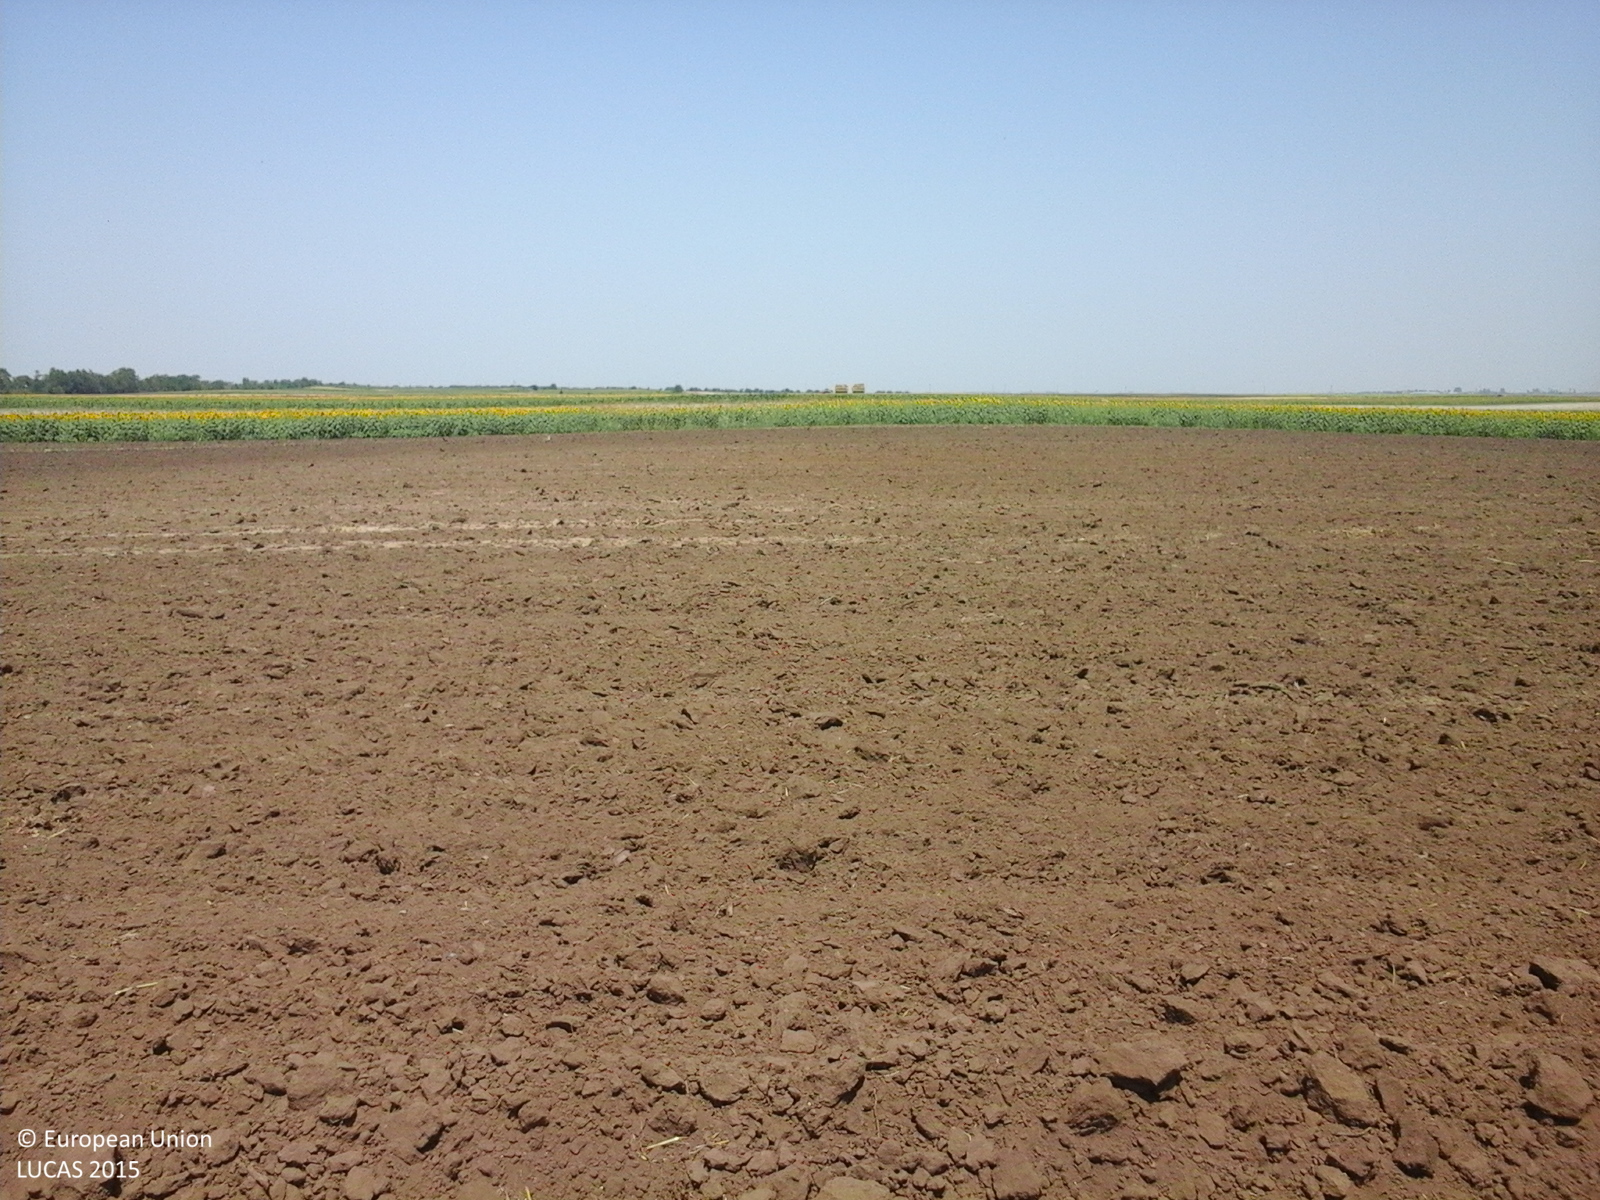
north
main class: Cropland
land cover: Rape and turnip rape
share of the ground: < 10 %
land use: Agriculture (excluding fallow land and kitchen gardens)
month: July
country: RO
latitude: 44.5446
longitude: 27.6040
